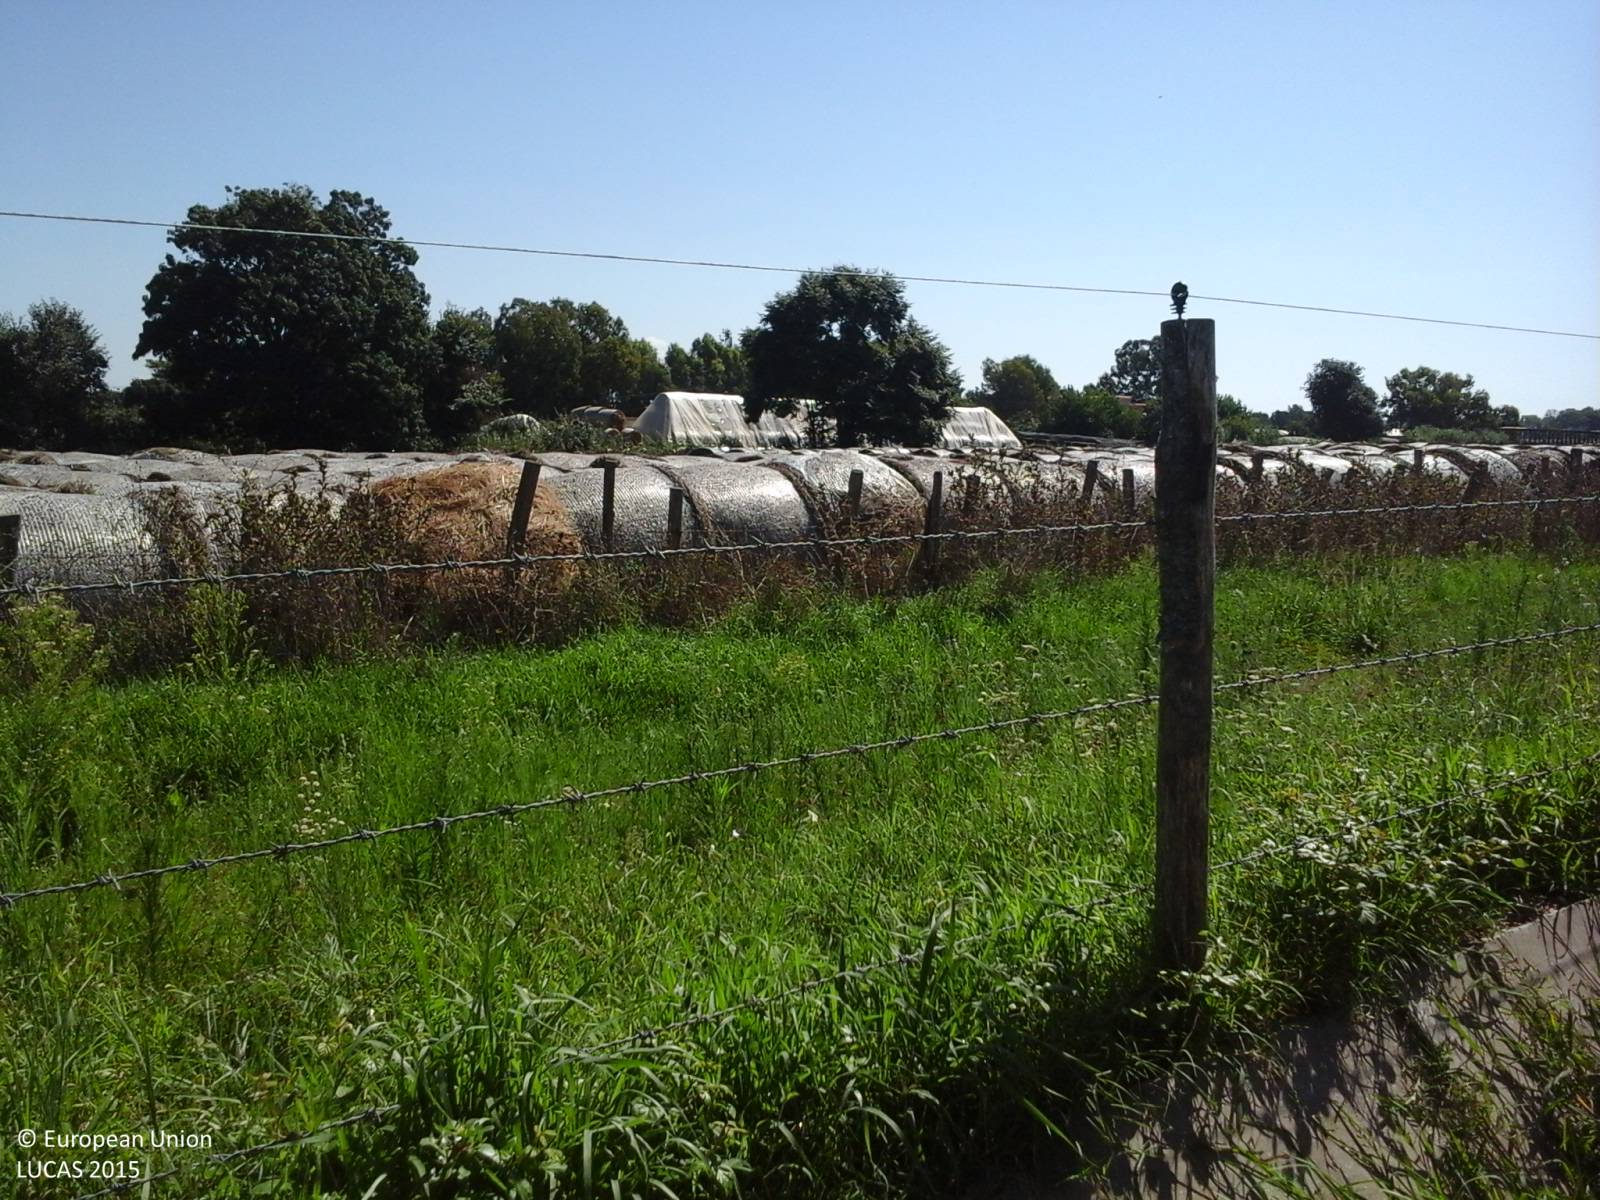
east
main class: Cropland
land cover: Maize
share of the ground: > 75 %
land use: Agriculture (excluding fallow land and kitchen gardens)
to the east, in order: Maize; Grass margins; Fences; Tracks; Fences; Grassland without tree/shrub cover; Fences; Broadleaved woodland; Ditches and canals; Other bare soil; Artificial constructions in urban areas; Grassland without tree/shrub cover; Inland fresh running water; Grassland without tree/shrub cover; Tracks; Grassland without tree/shrub cover; Artificial constructions in urban areas
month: August
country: IT
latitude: 41.3630
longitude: 12.9646
